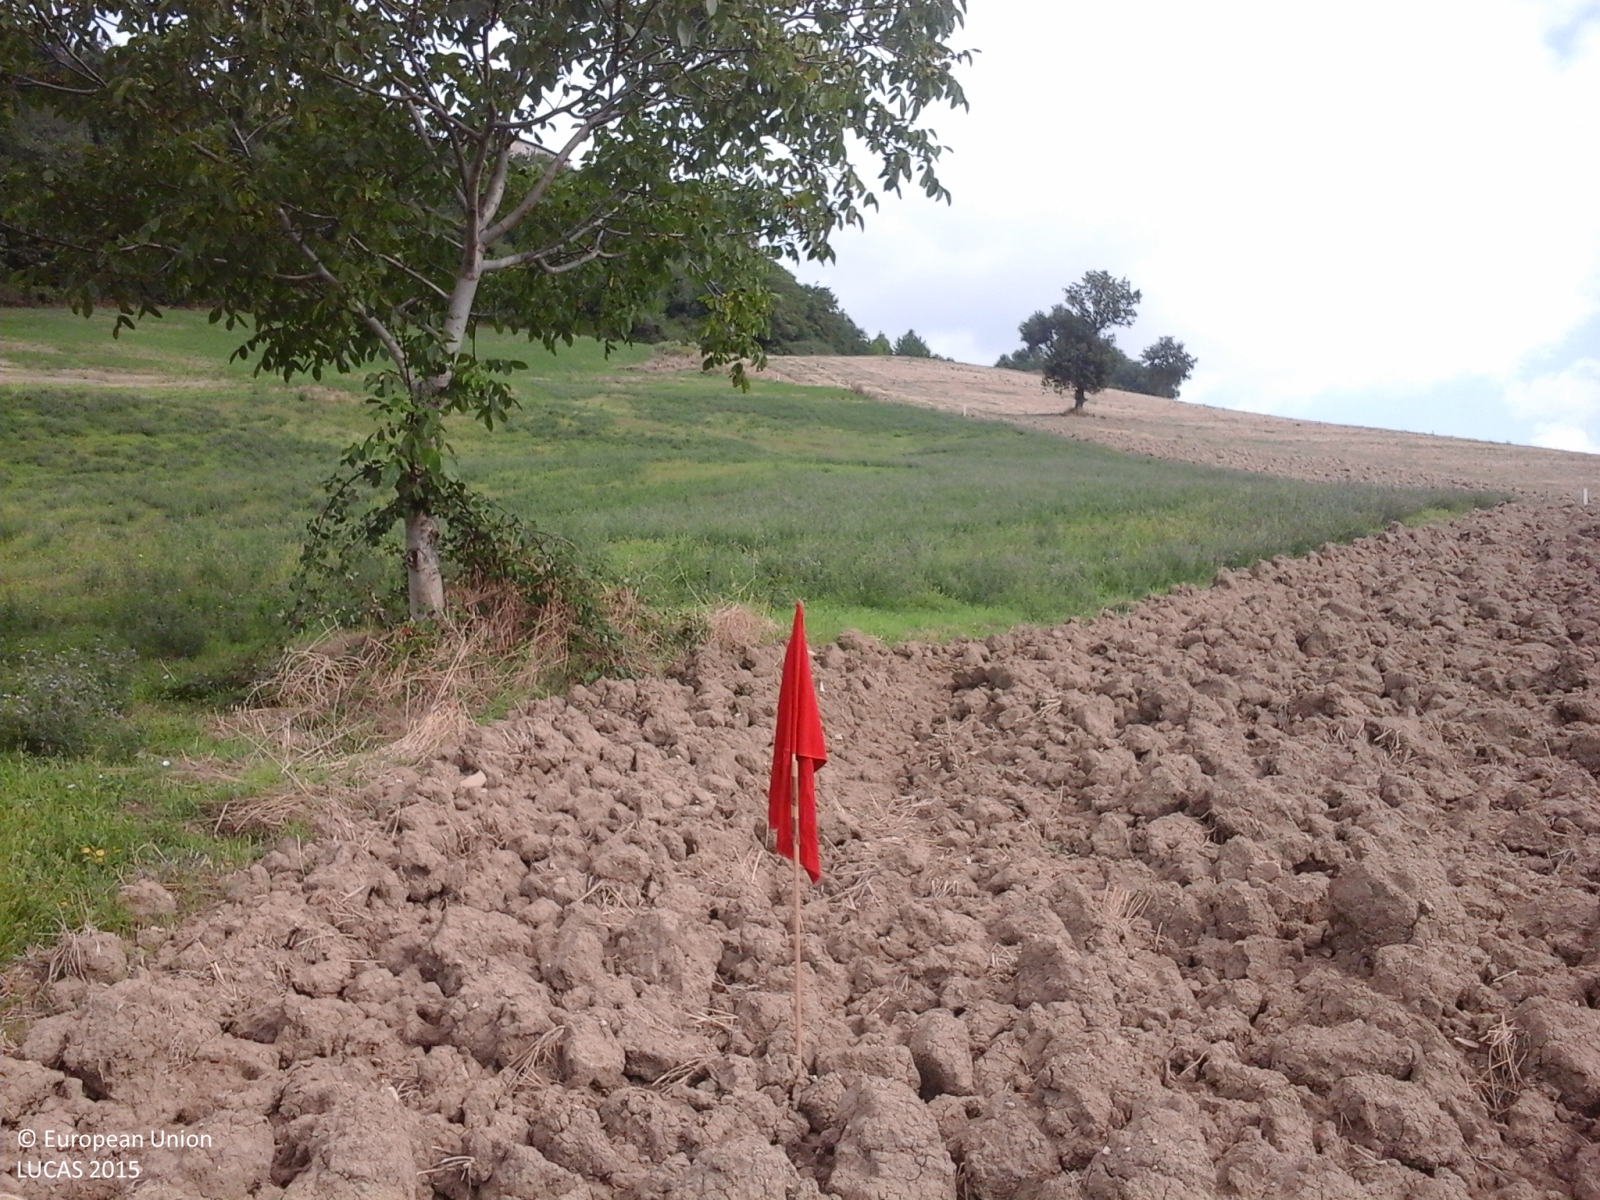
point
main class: Cropland
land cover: Durum wheat
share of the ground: < 10 %
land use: Agriculture (excluding fallow land and kitchen gardens)
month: August
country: IT
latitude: 43.3086
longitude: 13.1848
